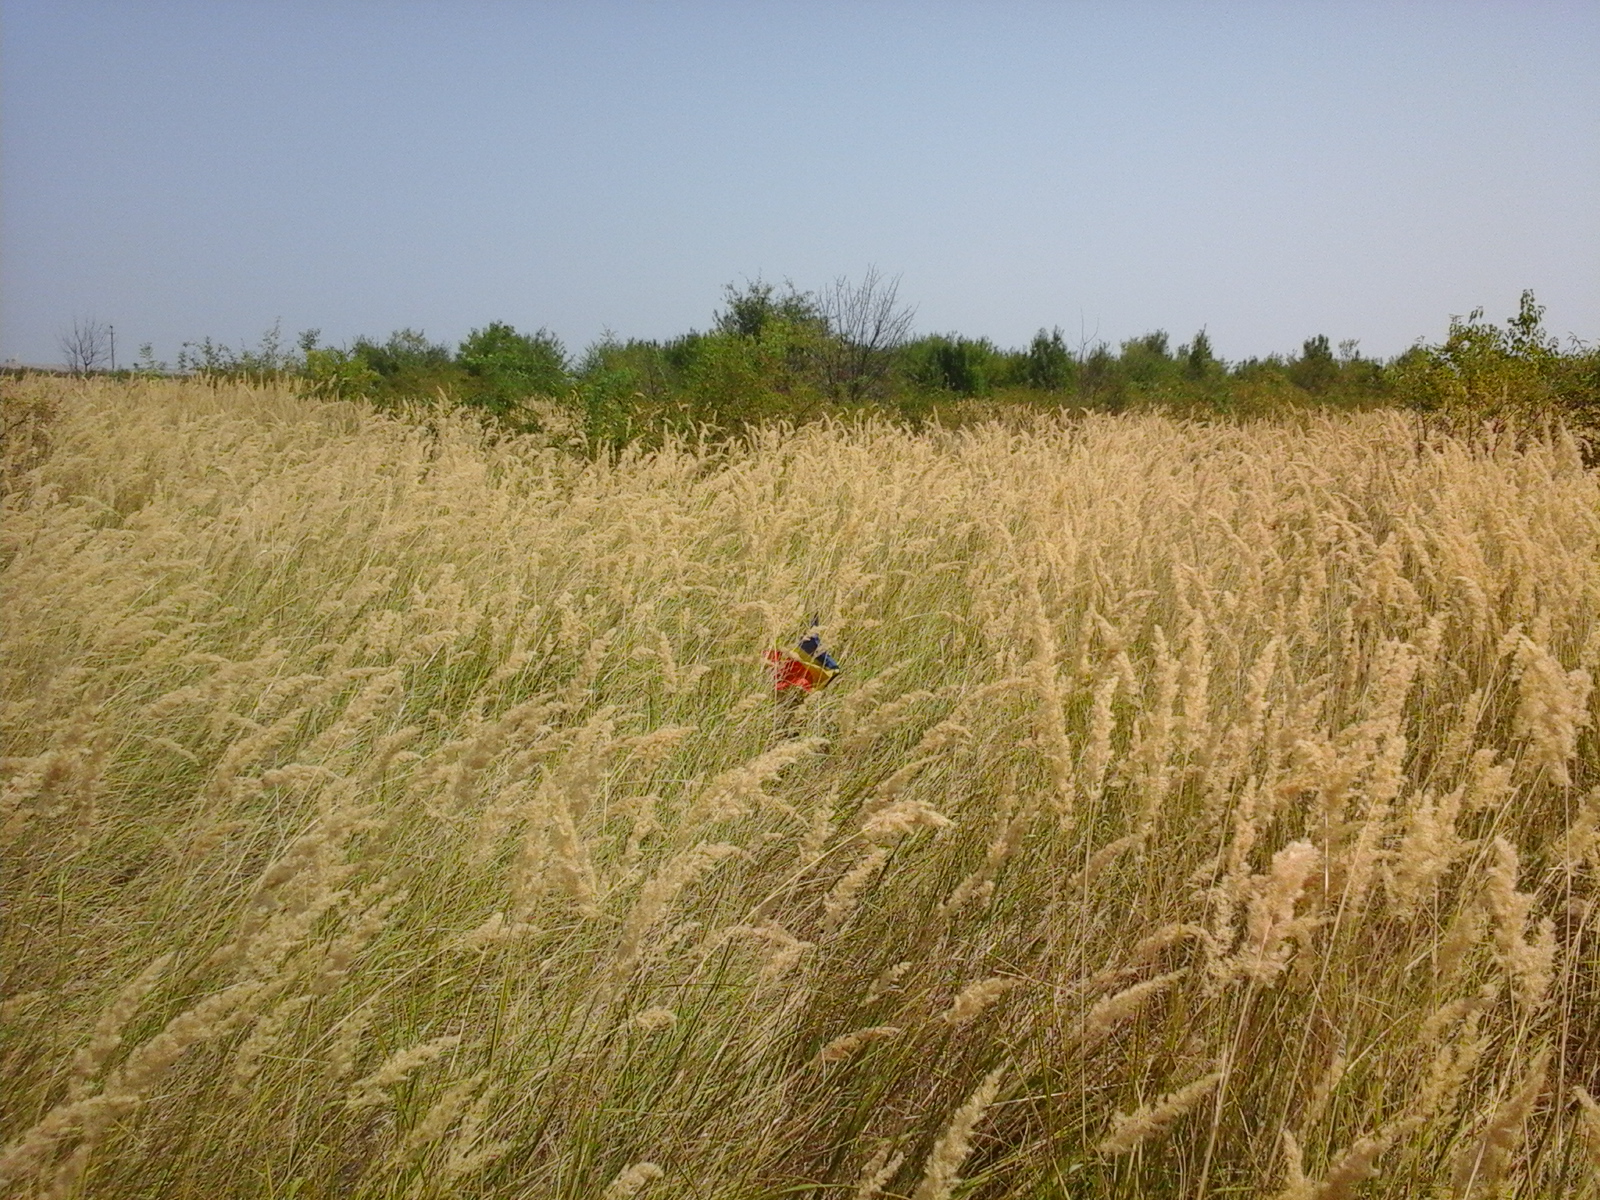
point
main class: Grassland
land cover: Grassland with sparse tree/shrub cover
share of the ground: > 75 %
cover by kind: herbaceous plants 85 %, shrubs 10 %, broadleaved forest trees 5 %
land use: Fallow land
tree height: < 5 m
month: August
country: RO
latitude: 44.4699
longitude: 22.6229
